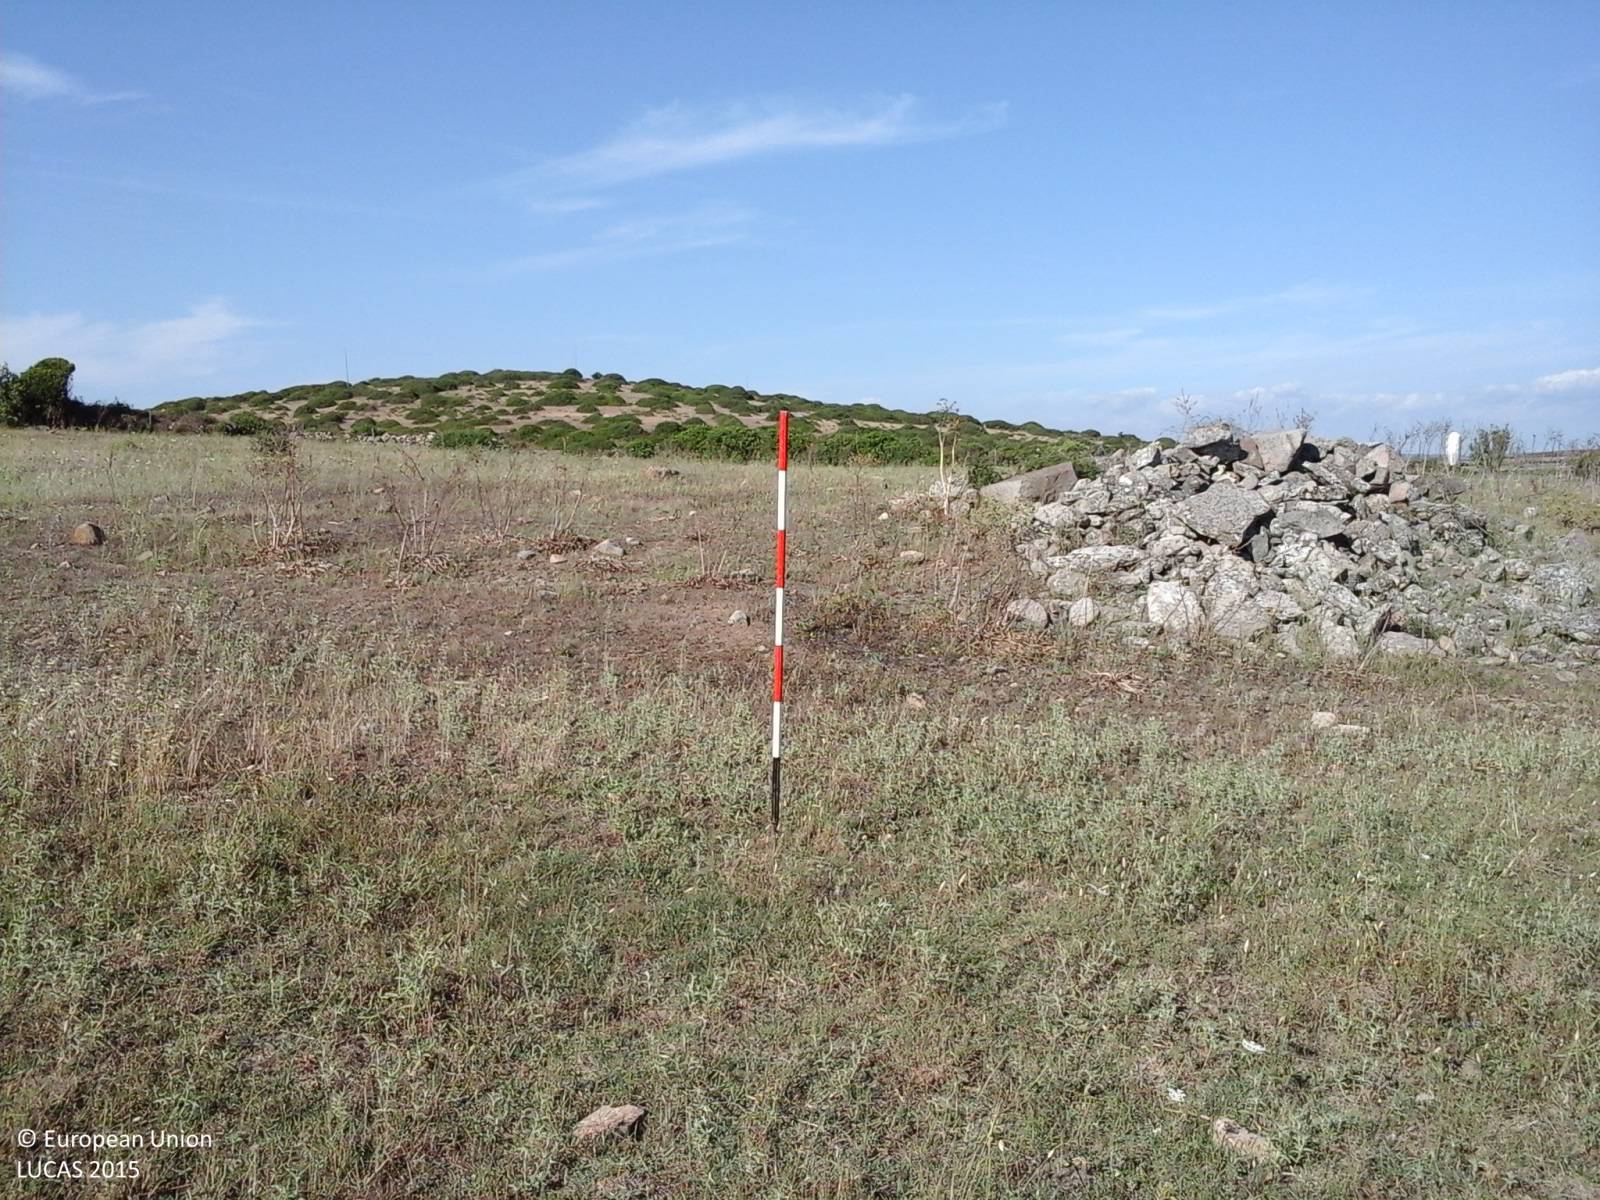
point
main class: Grassland
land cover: Grassland without tree/shrub cover
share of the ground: > 75 %
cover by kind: herbaceous plants 100 %
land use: Agriculture (excluding fallow land and kitchen gardens)
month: June
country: IT
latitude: 39.8094
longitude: 8.9895
